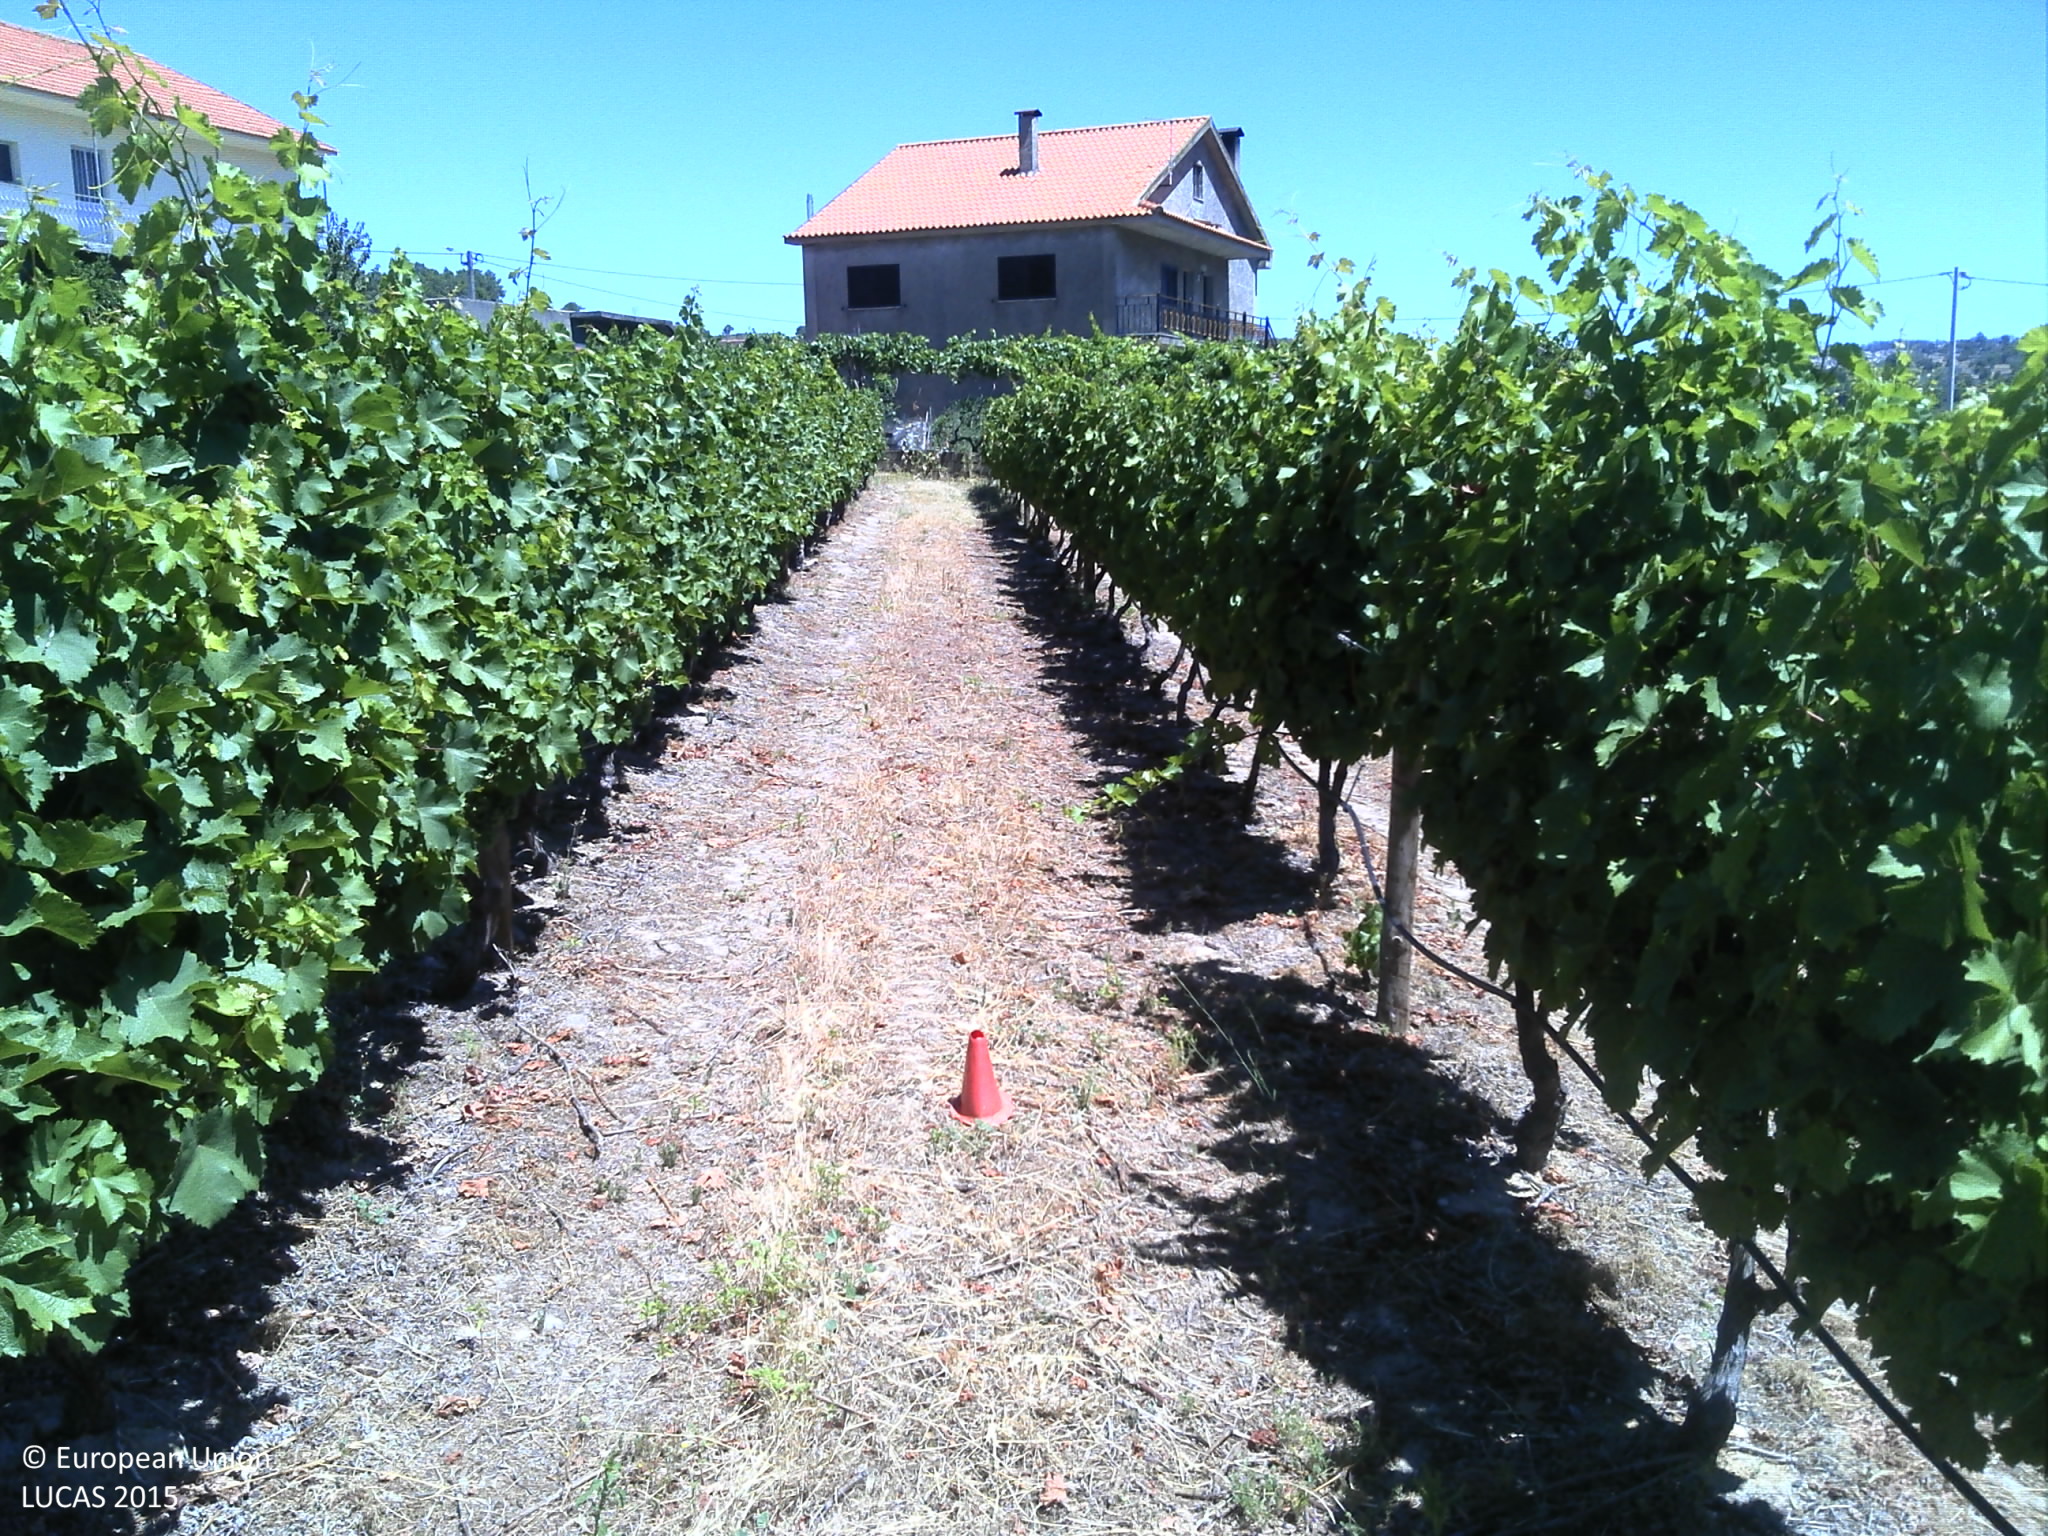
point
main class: Cropland
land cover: Vineyards
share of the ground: < 10 %
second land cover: Other bare soil
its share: > 75 %
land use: Agriculture (excluding fallow land and kitchen gardens)
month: July
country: PT
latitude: 41.2770
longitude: -7.3227
